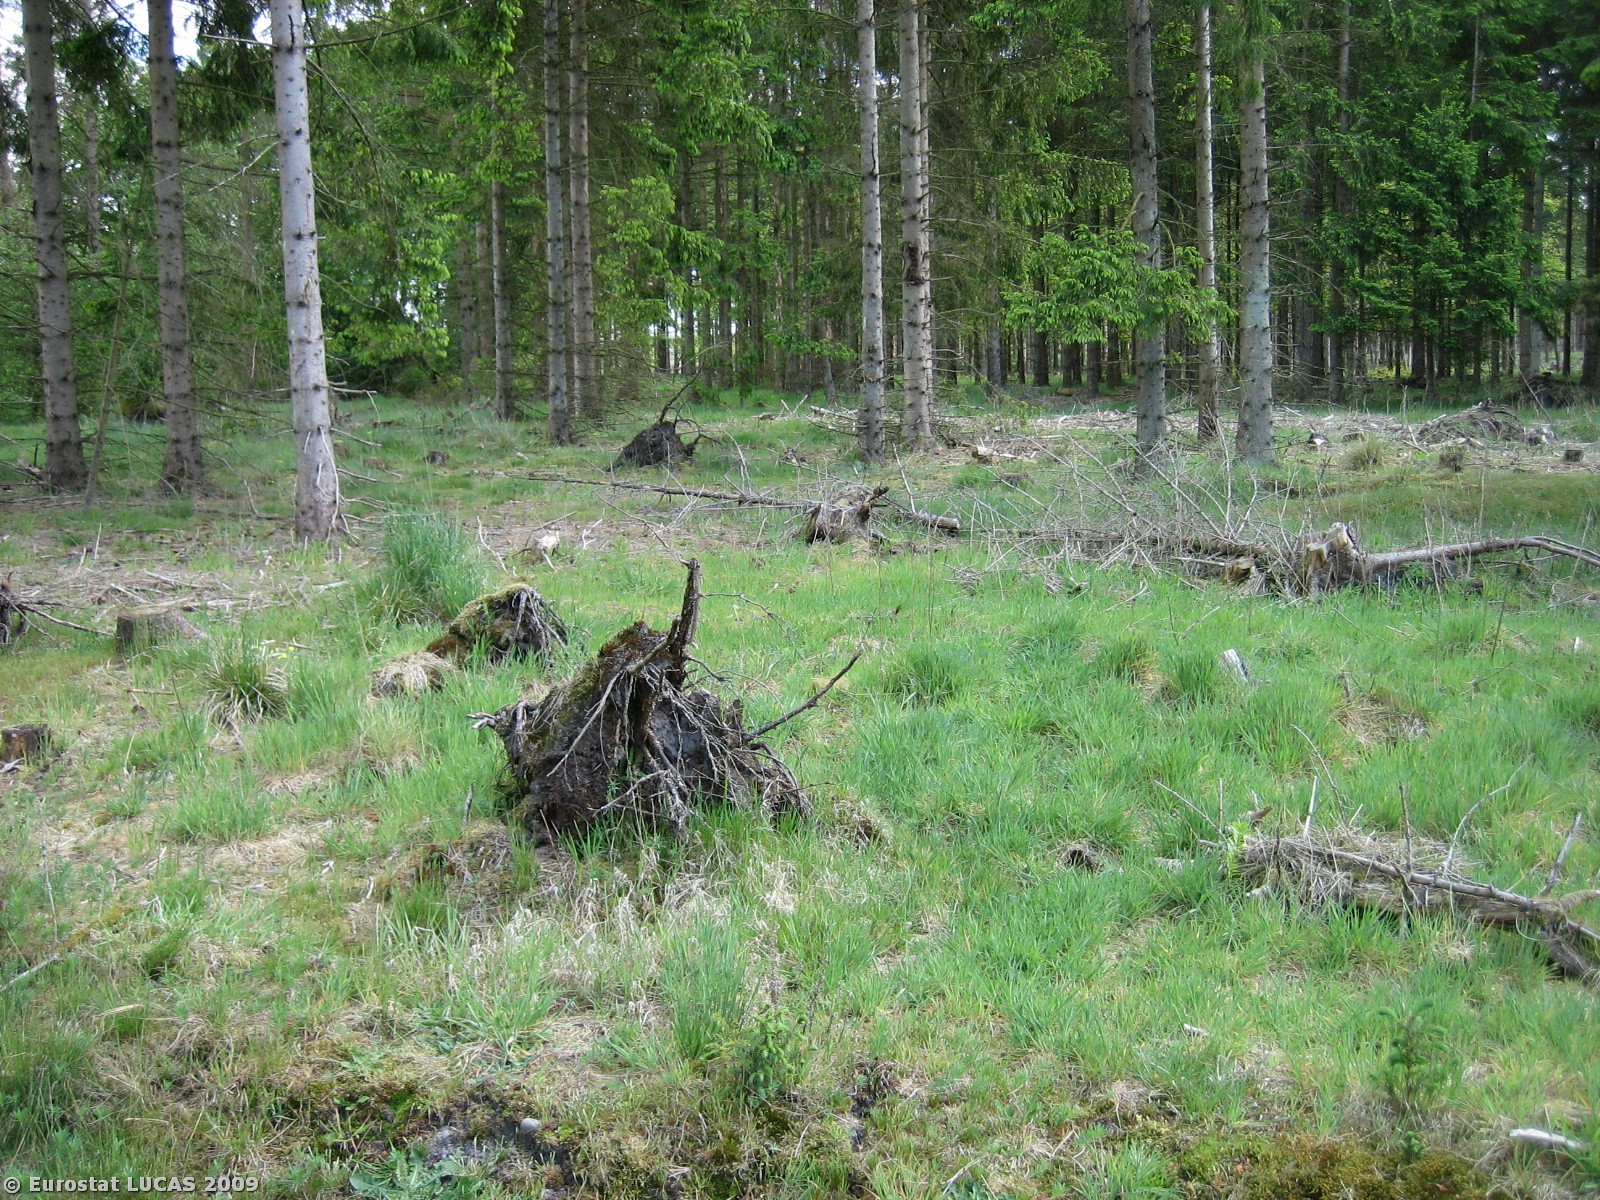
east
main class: Woodland
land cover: Coniferous woodland
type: hemiboreal forest and nemoral coniferous forest and mixed broadleaved-coniferous forest
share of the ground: 25 - 50 %
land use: Forestry
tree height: > 5 m
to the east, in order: Coniferous woodland; Grass margins; Coniferous woodland; Broadleaved woodland; Coniferous woodland; Broadleaved woodland; Grassland without tree/shrub cover; Inland marshes; Rivers and streams; Inland marshes
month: May
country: DK
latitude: 56.2551
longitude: 8.9198
